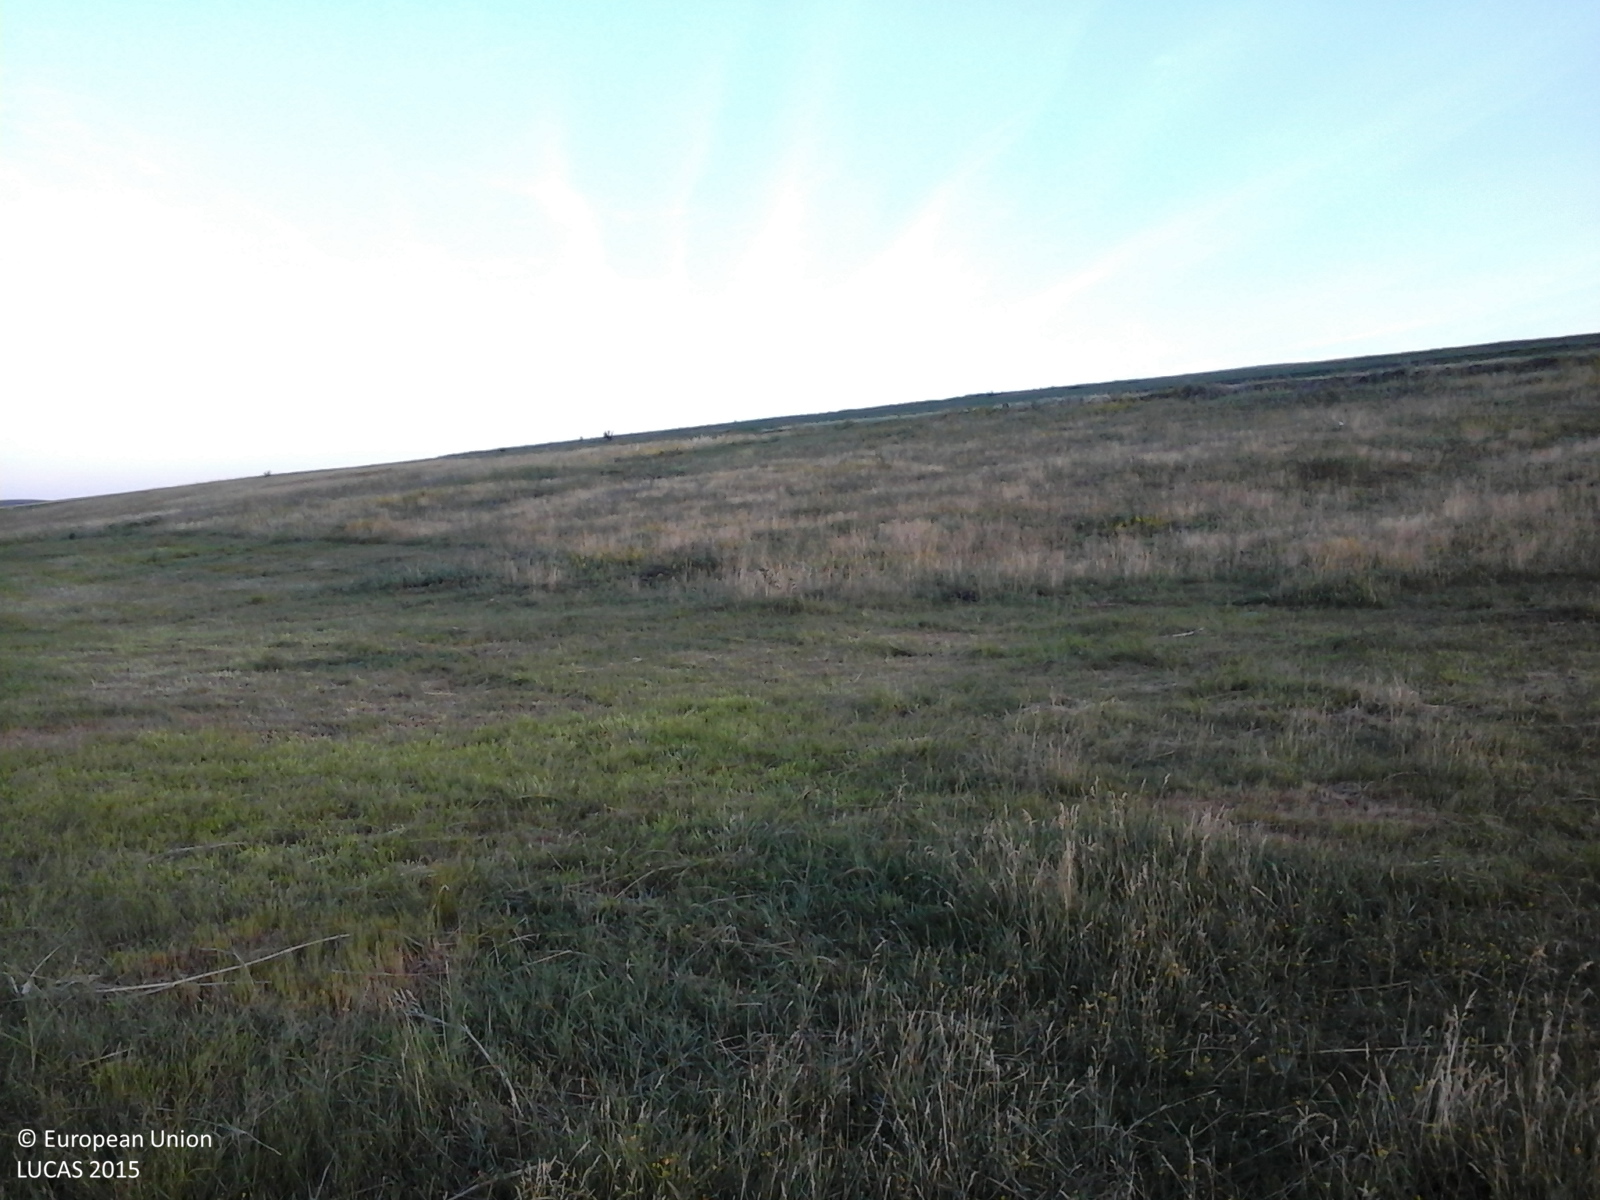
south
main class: Grassland
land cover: Grassland without tree/shrub cover
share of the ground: > 75 %
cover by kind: herbaceous plants 100 %
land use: Agriculture (excluding fallow land and kitchen gardens)
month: June
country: RO
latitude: 47.4411
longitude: 27.1194
